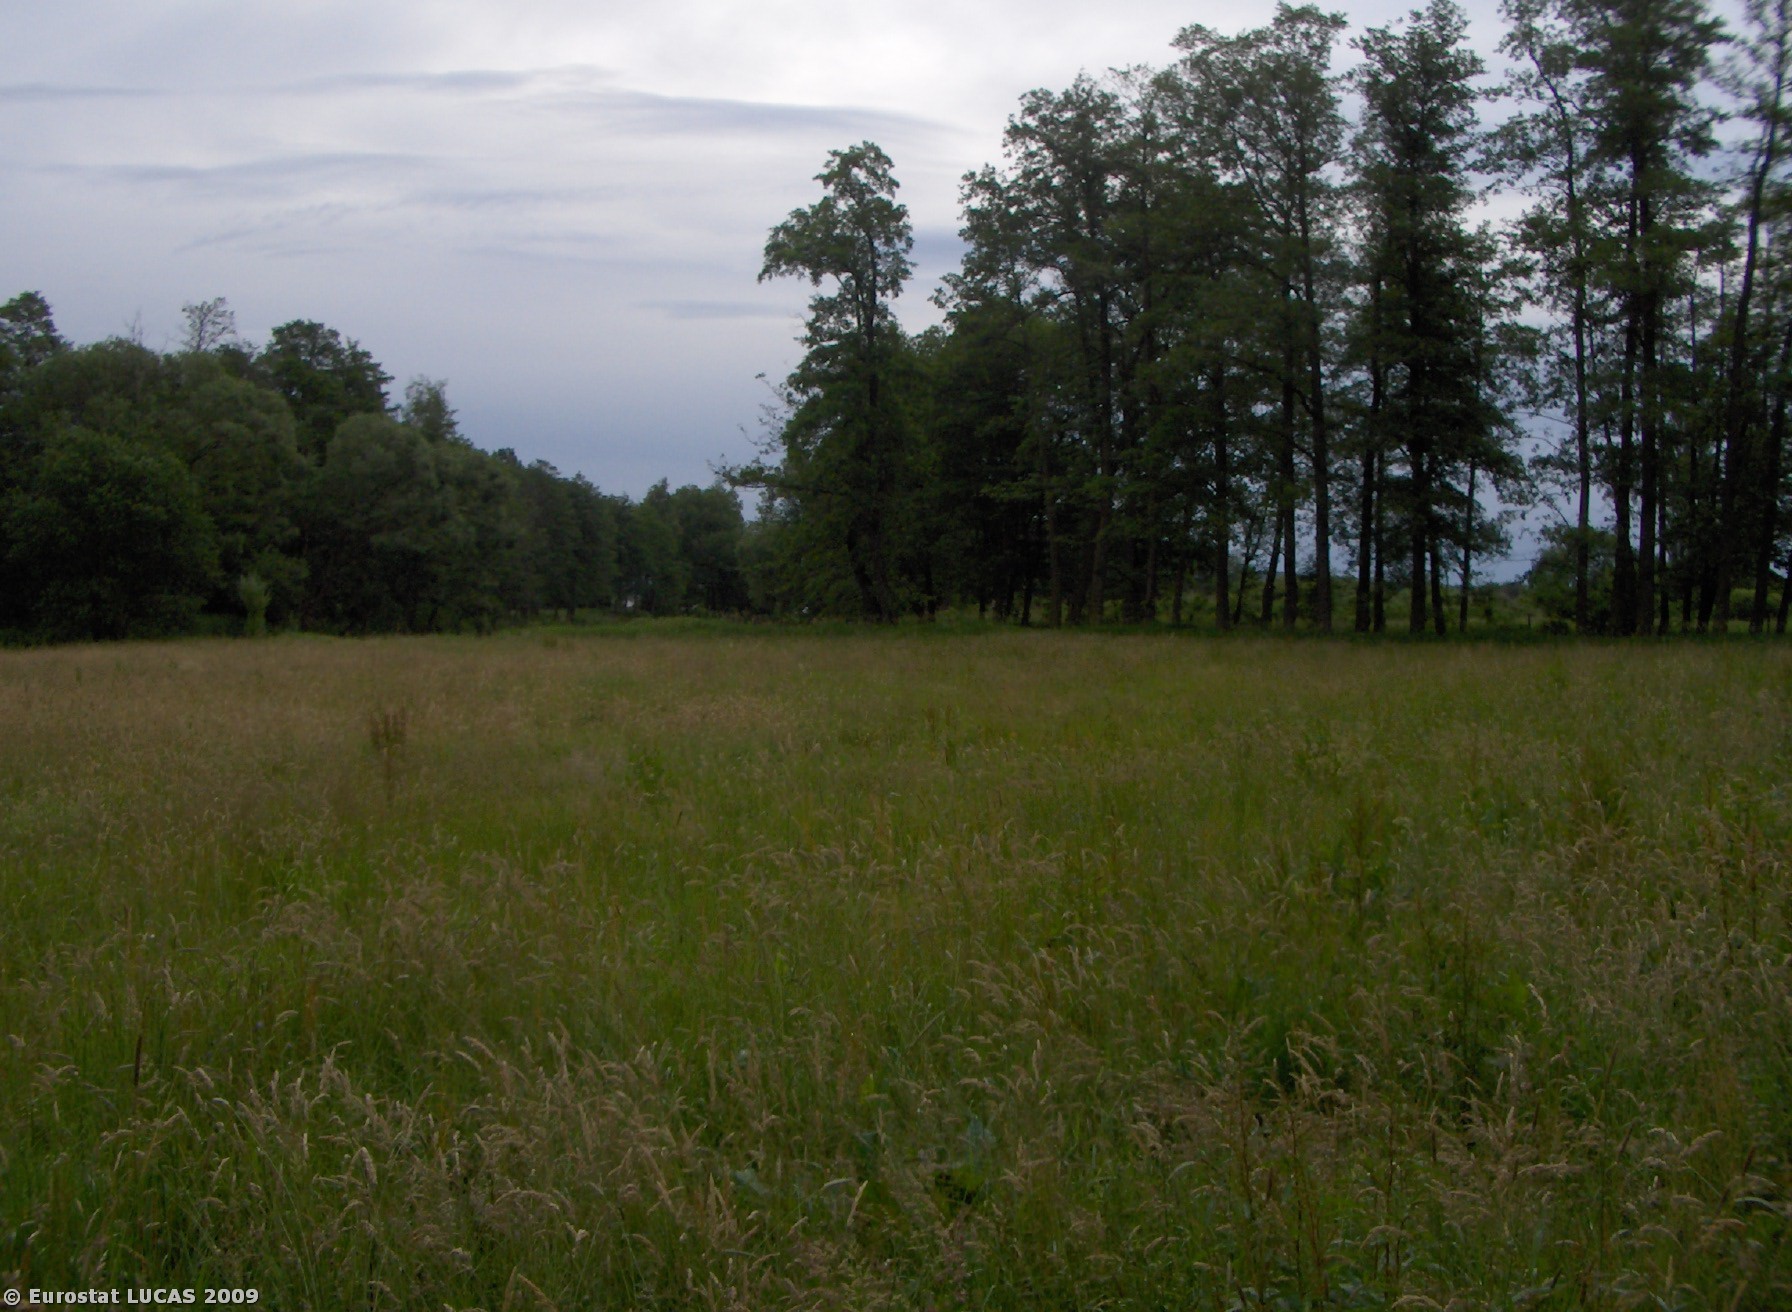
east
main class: Grassland
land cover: Grassland without tree/shrub cover
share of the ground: > 75 %
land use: Agriculture (excluding fallow land and kitchen gardens)
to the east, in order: Grassland without tree/shrub cover; Inland water bodies
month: June
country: CZ
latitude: 49.1531
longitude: 14.1826
